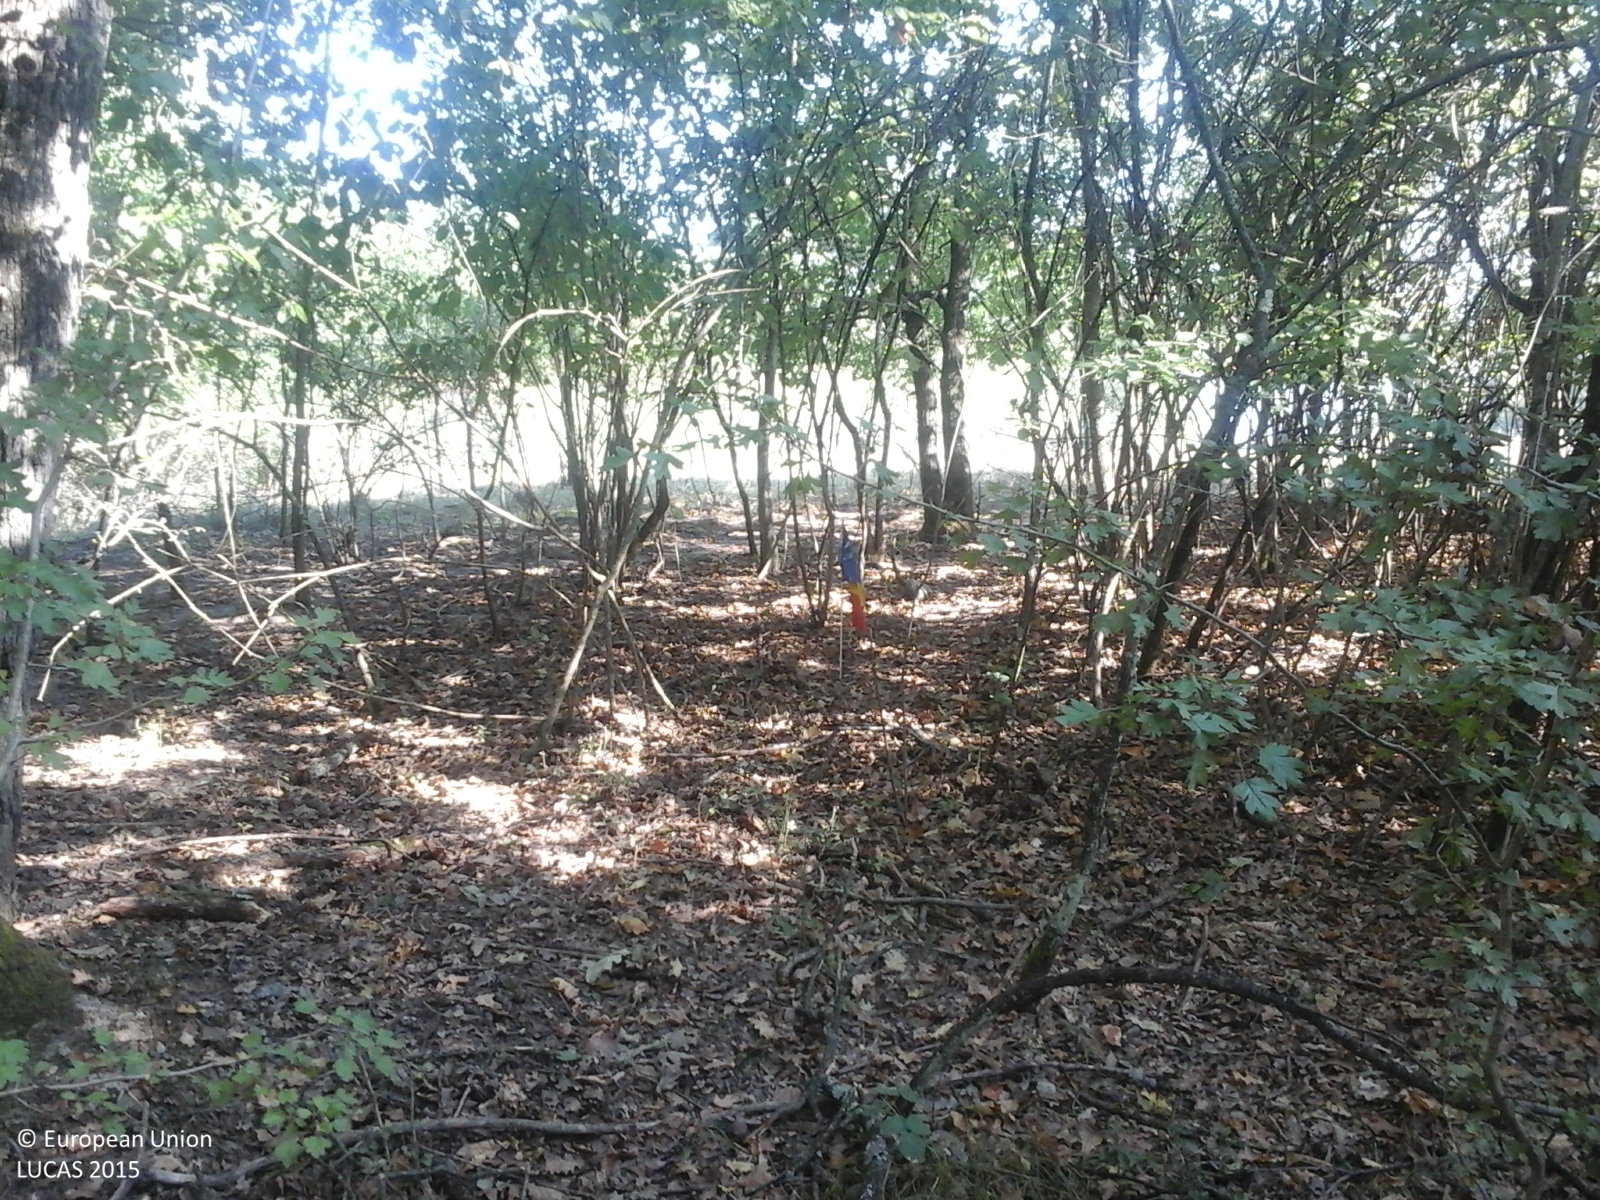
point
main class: Woodland
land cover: Broadleaved woodland
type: acidophilous oak and oak-birch forest
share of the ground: > 75 %
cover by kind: broadleaved forest trees 100 %
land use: Forestry
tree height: > 5 m
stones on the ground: < 10 %
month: August
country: RO
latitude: 46.4133
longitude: 22.2108
